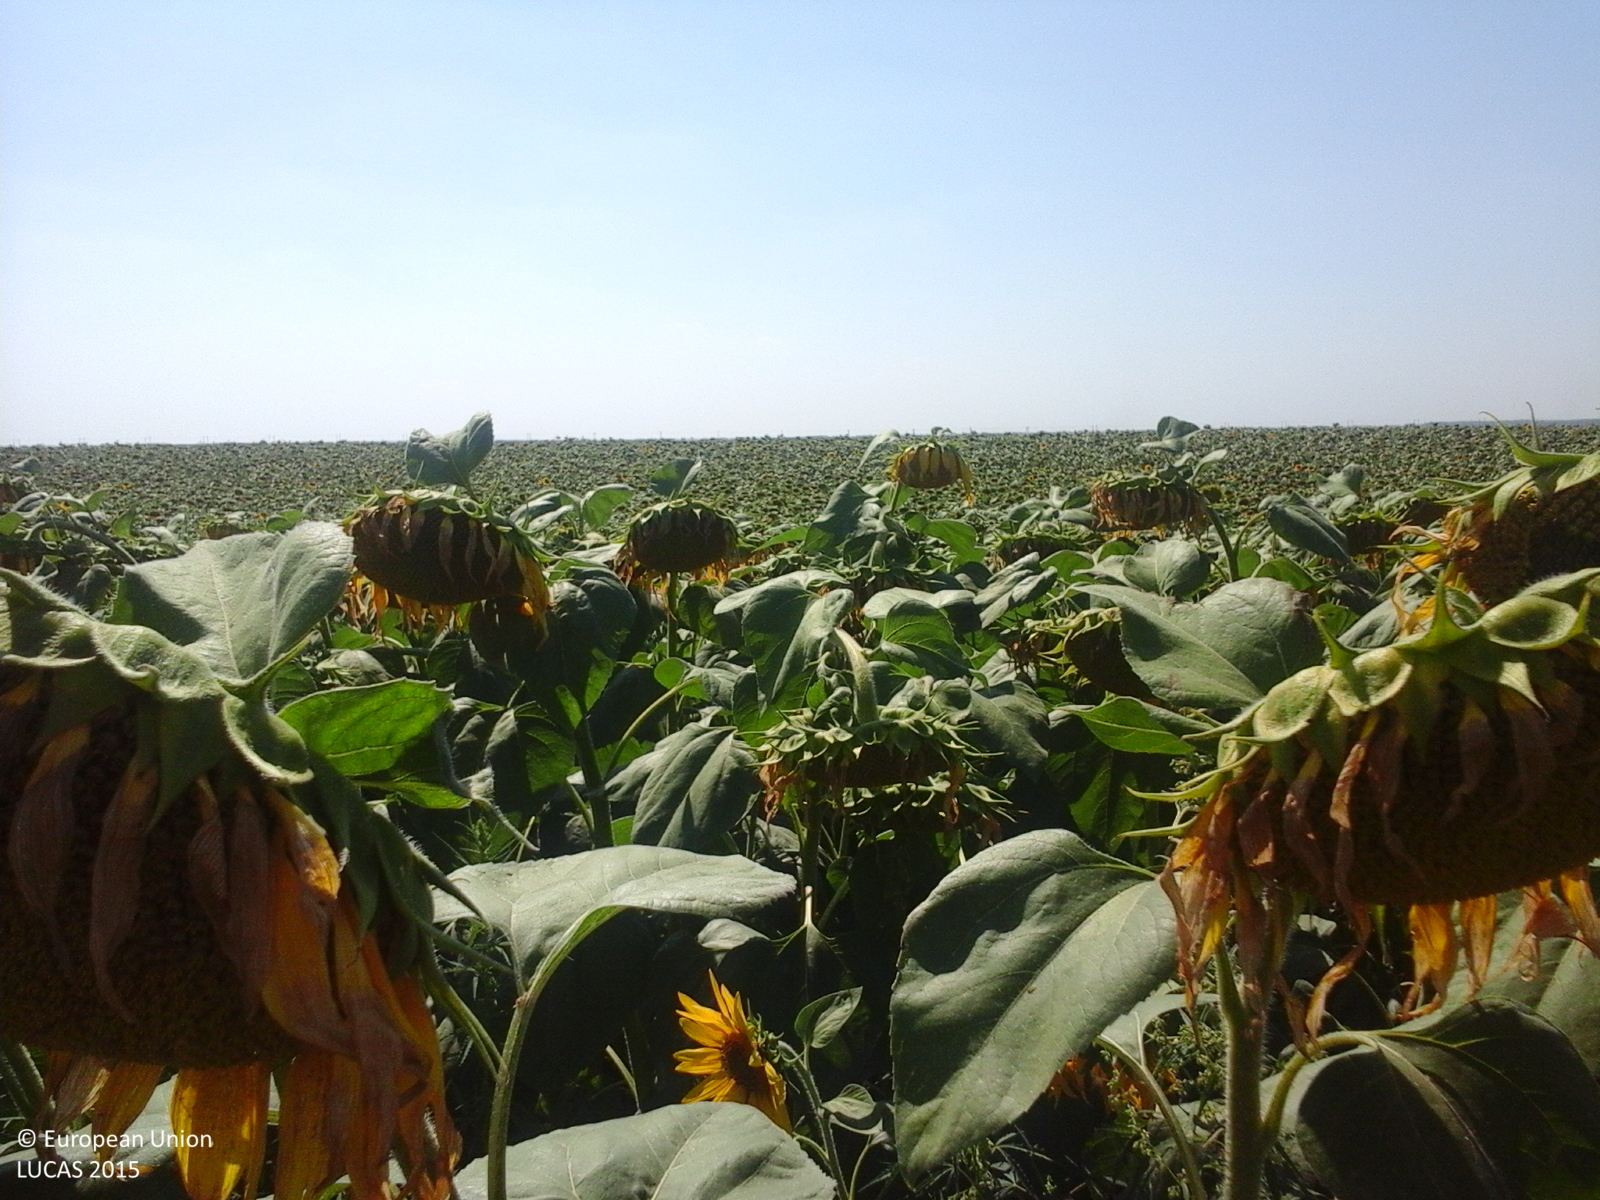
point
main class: Cropland
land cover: Sunflower
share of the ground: > 75 %
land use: Agriculture (excluding fallow land and kitchen gardens)
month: July
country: RO
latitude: 44.3859
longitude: 27.3468
